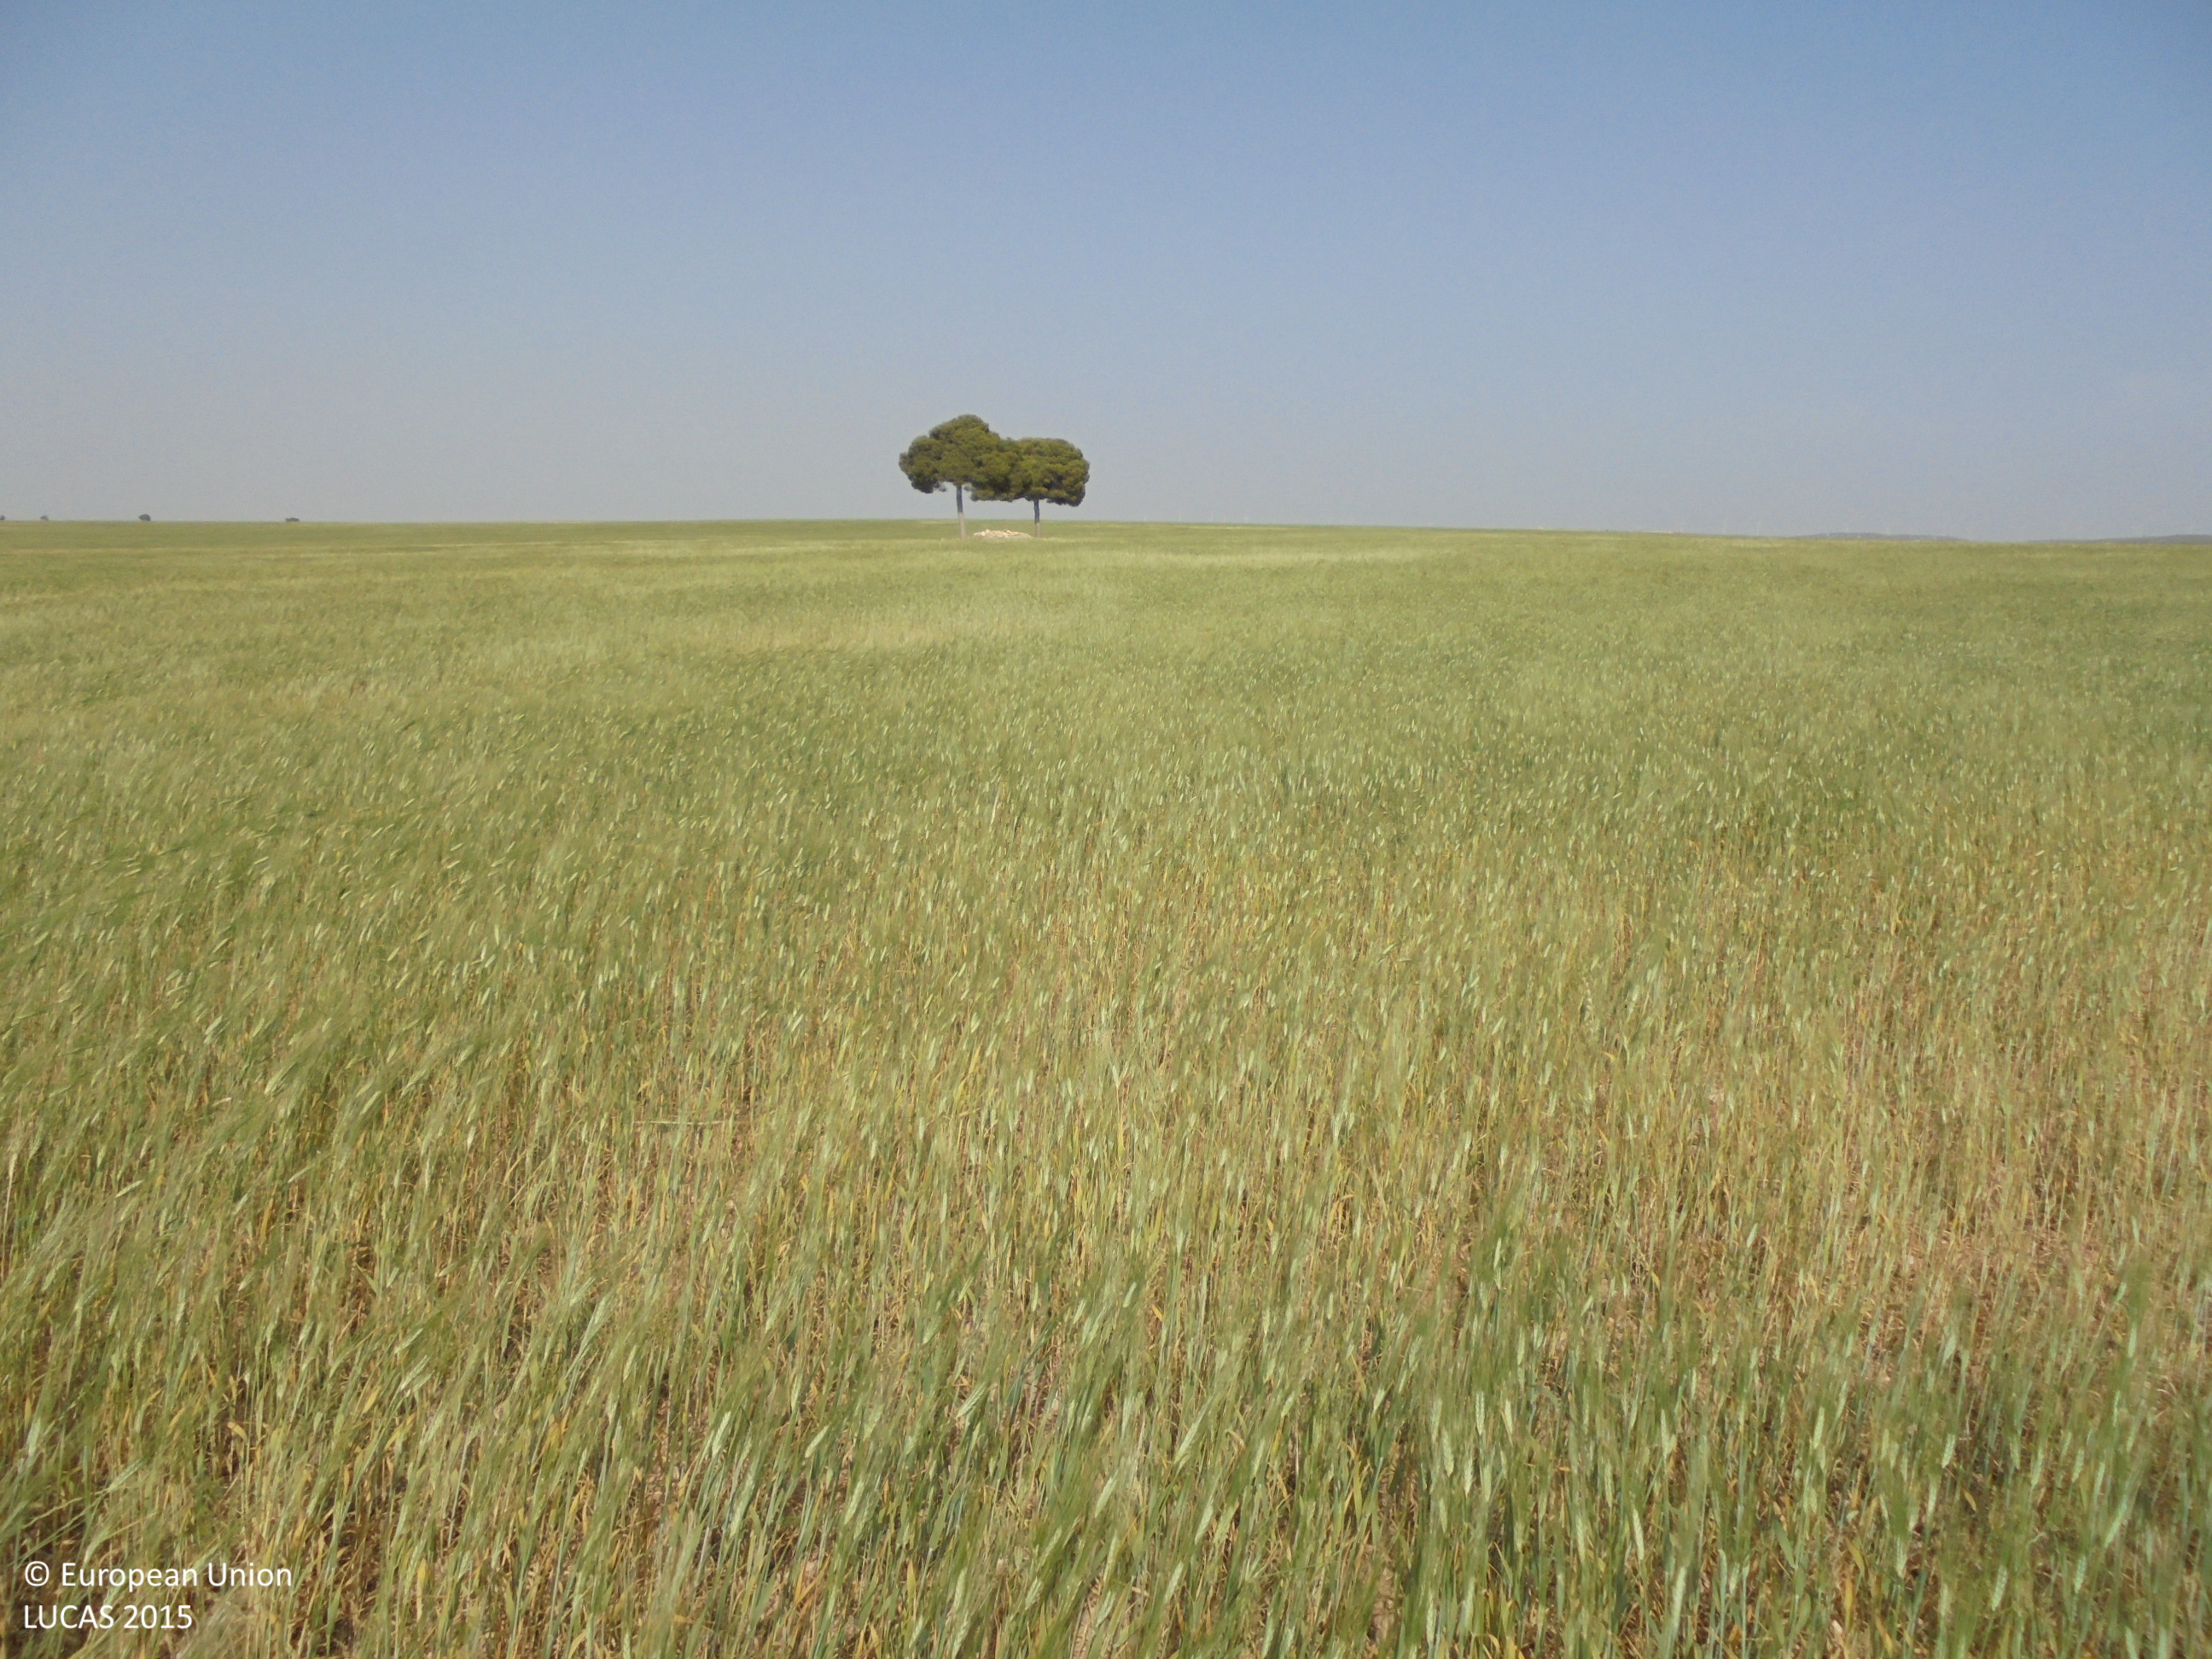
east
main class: Cropland
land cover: Barley
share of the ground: 25 - 50 %
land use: Agriculture (excluding fallow land and kitchen gardens)
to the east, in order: Barley; Grass margins; Barley
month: May
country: ES
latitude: 39.0814
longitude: -1.6176
